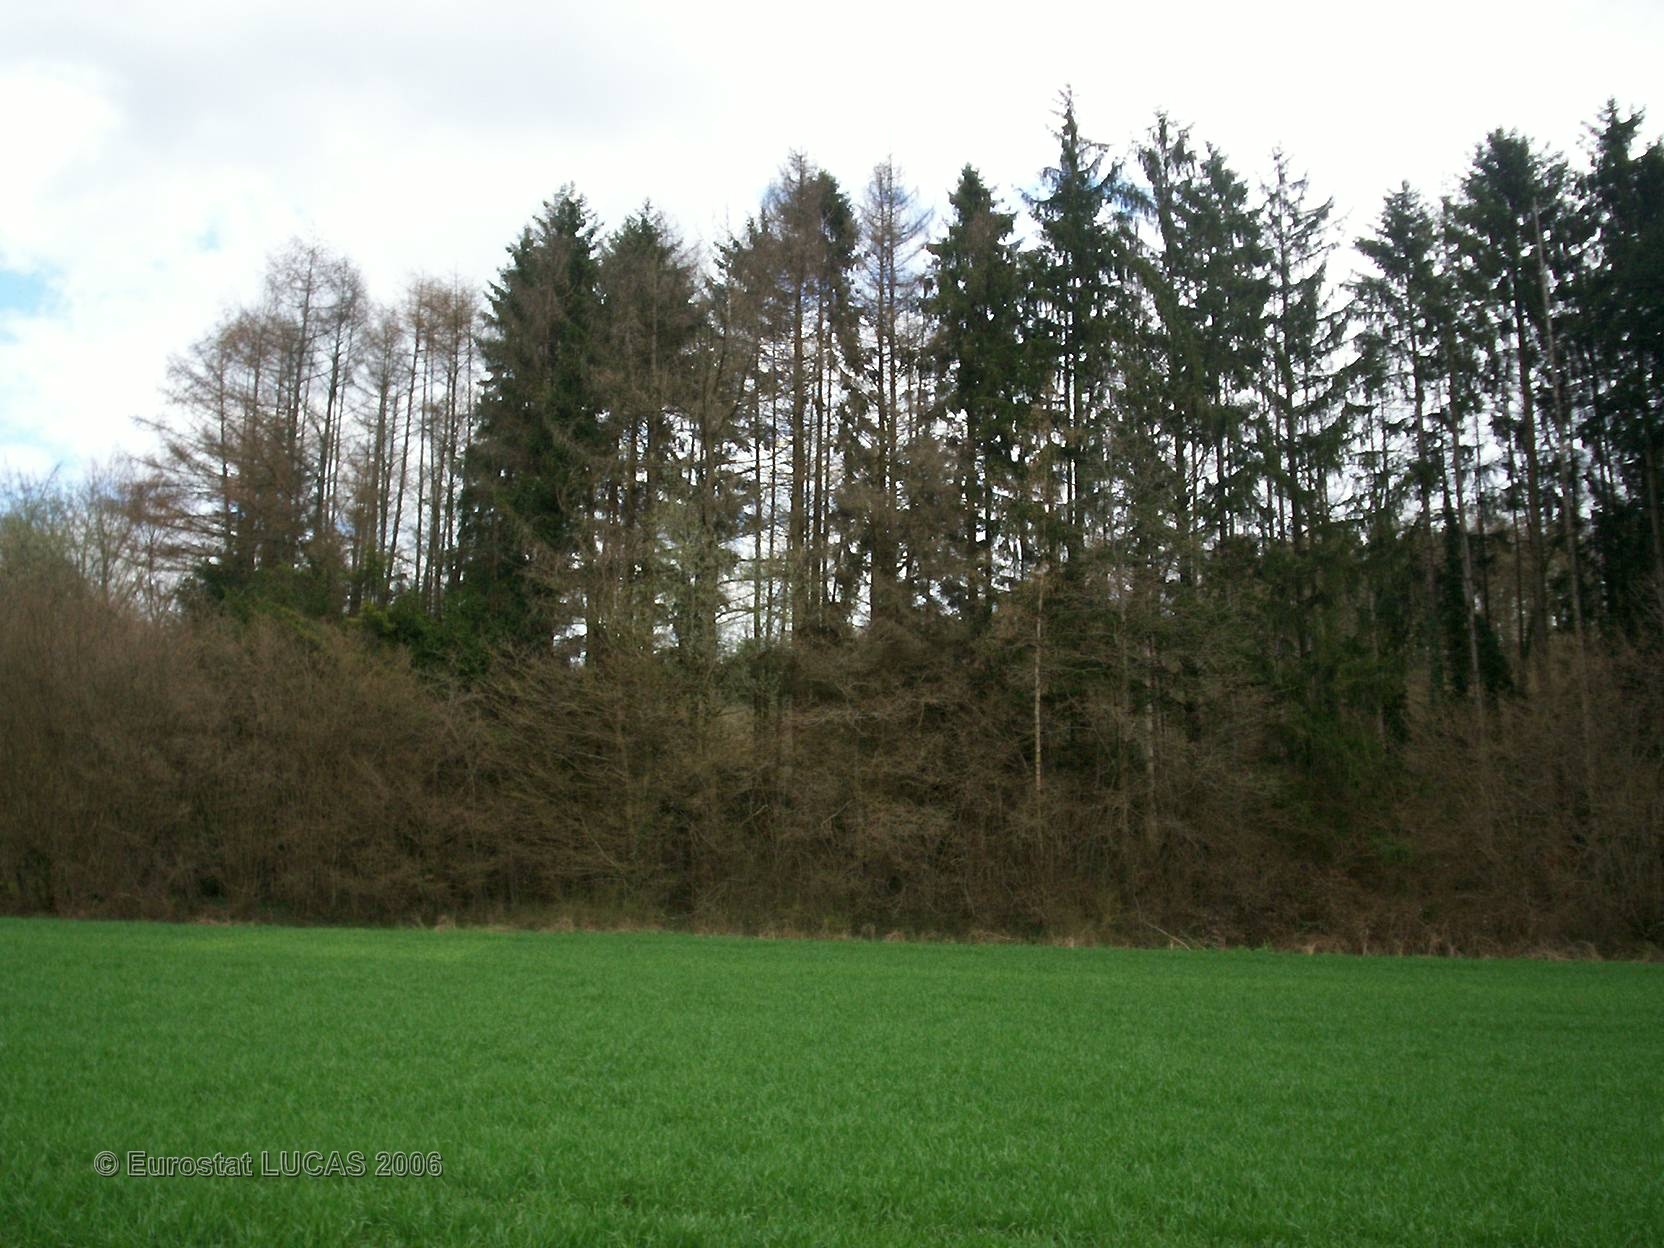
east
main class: Cropland
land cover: Common wheat
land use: Agriculture (excluding fallow land and kitchen gardens)
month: April
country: FR
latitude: 47.5043
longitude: 6.5896
